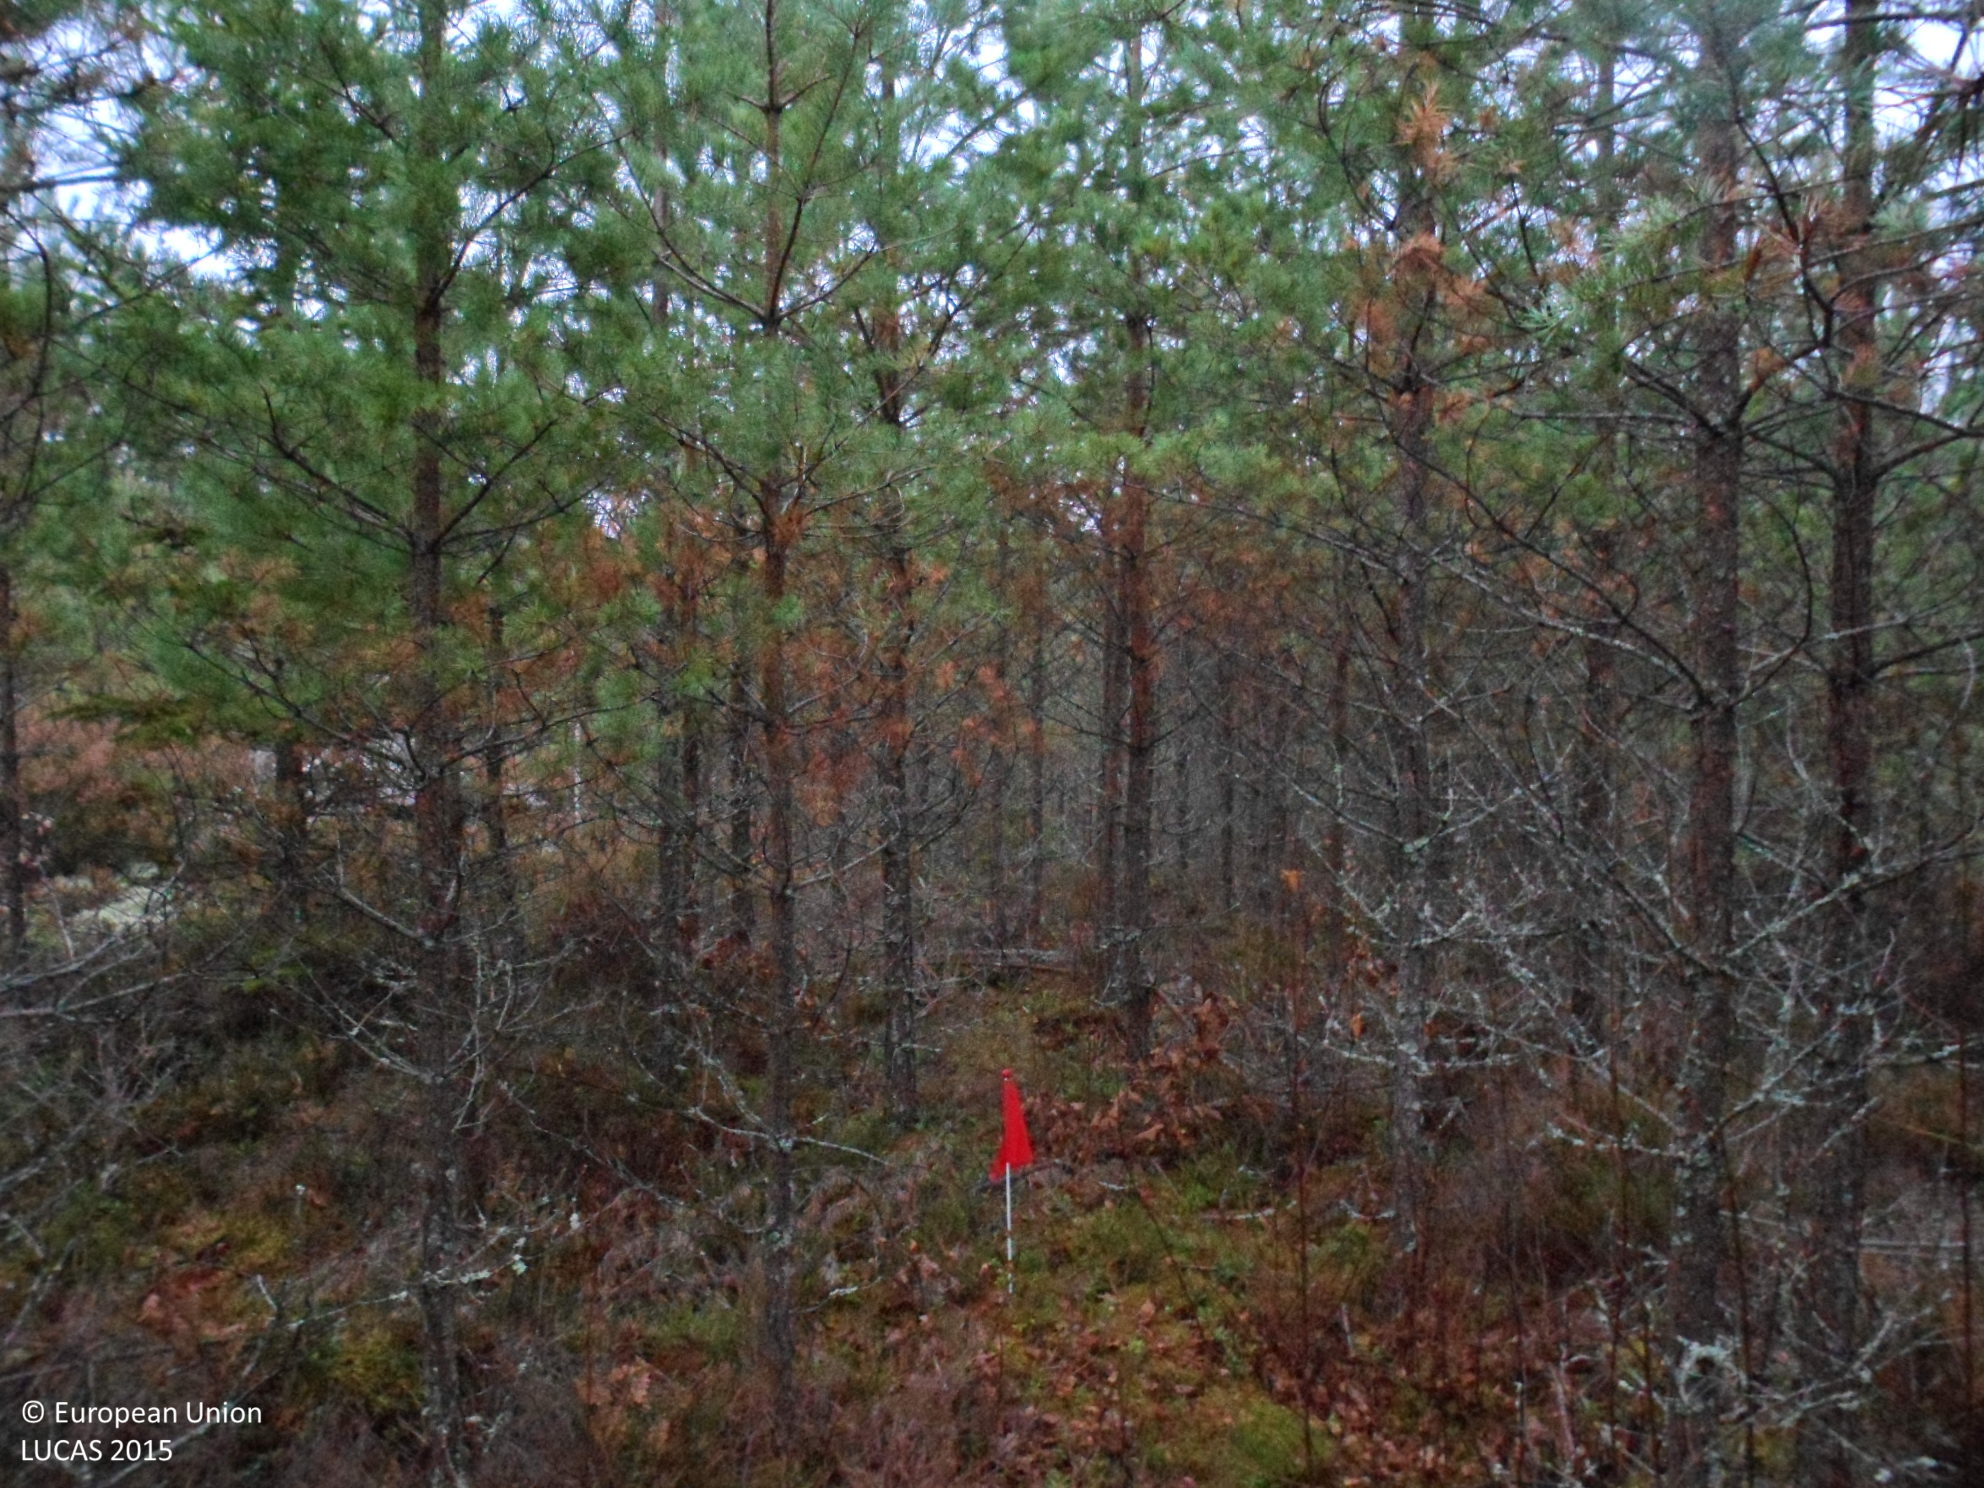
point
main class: Woodland
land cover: Pine dominated coniferous woodland
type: boreal forest
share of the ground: 50 - 75 %
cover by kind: coniferous forest trees 55 %, shrubs 30 %, lichens and mosses 10 %, broadleaved forest trees 5 %
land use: Forestry
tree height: < 5 m
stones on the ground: > 50 %
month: November
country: SE
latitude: 57.0223
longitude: 15.9785
